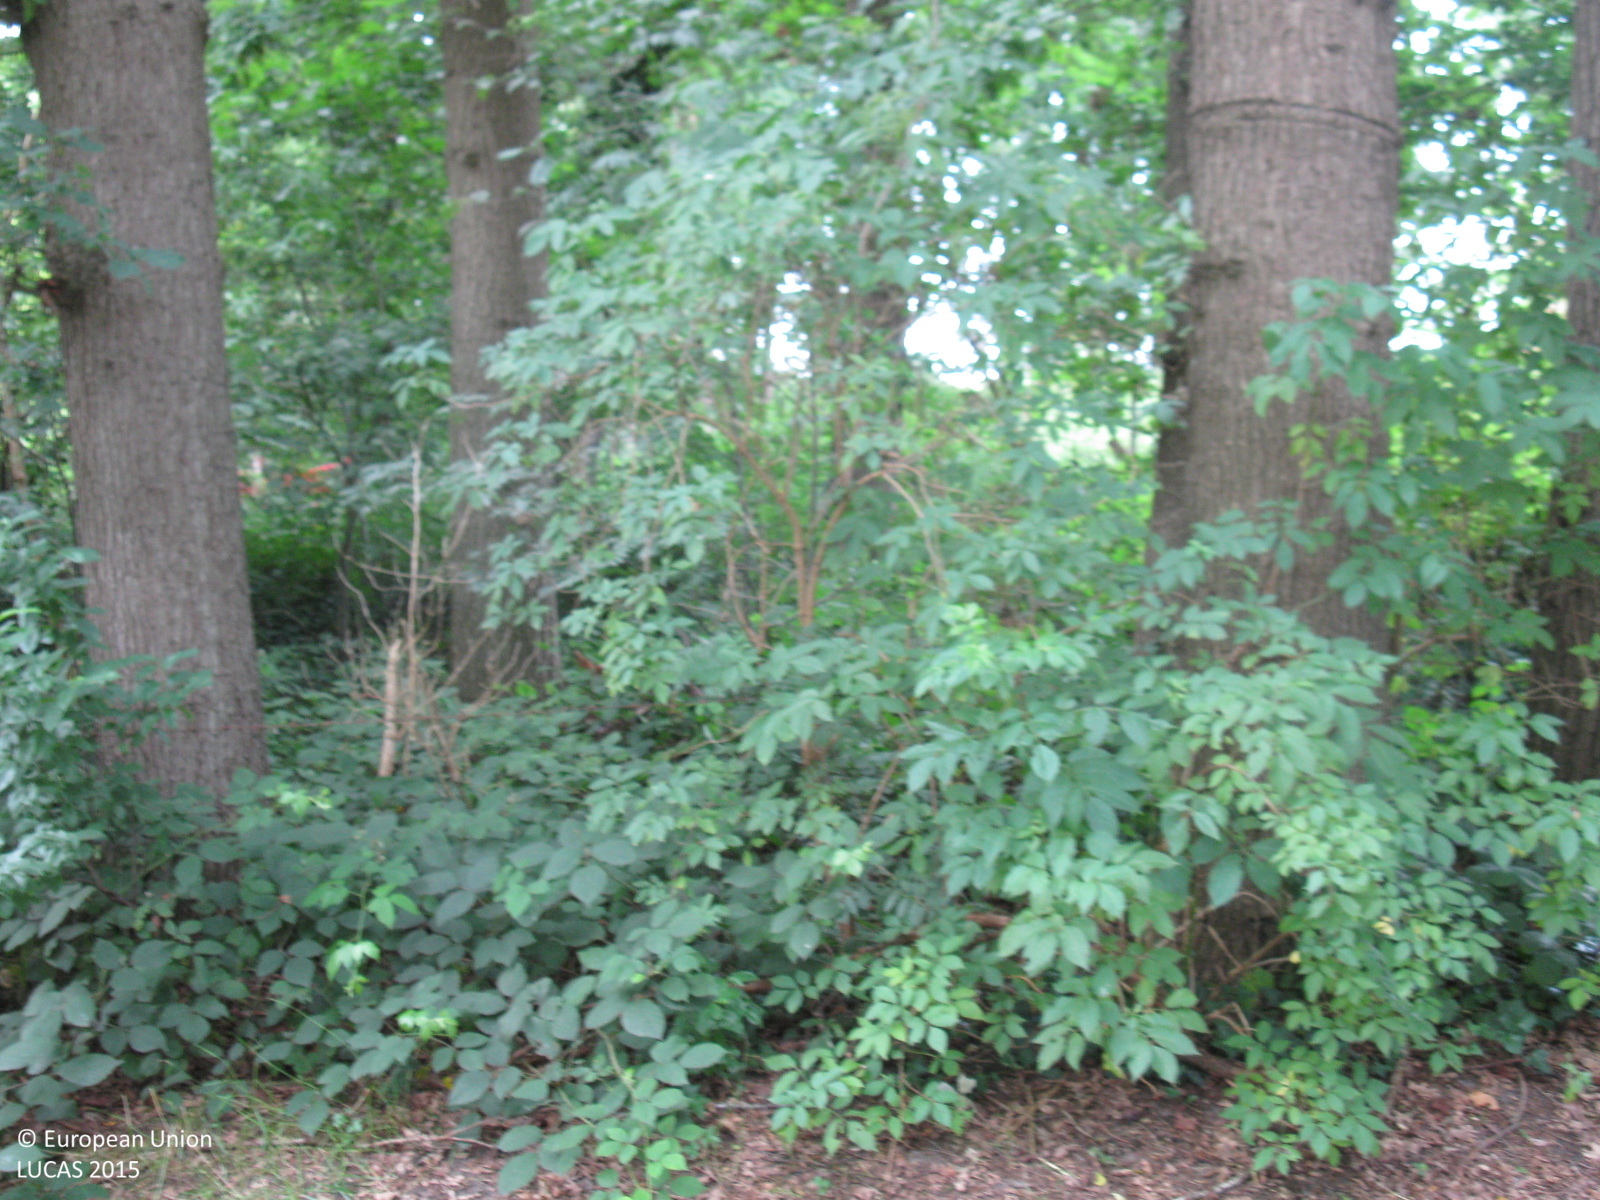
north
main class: Woodland
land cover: Broadleaved woodland
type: mesophytic deciduous forest
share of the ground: > 75 %
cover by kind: broadleaved forest trees 100 %
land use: Semi-natural and natural areas not in use
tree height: > 5 m
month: July
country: DE
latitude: 53.0241
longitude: 7.8984
